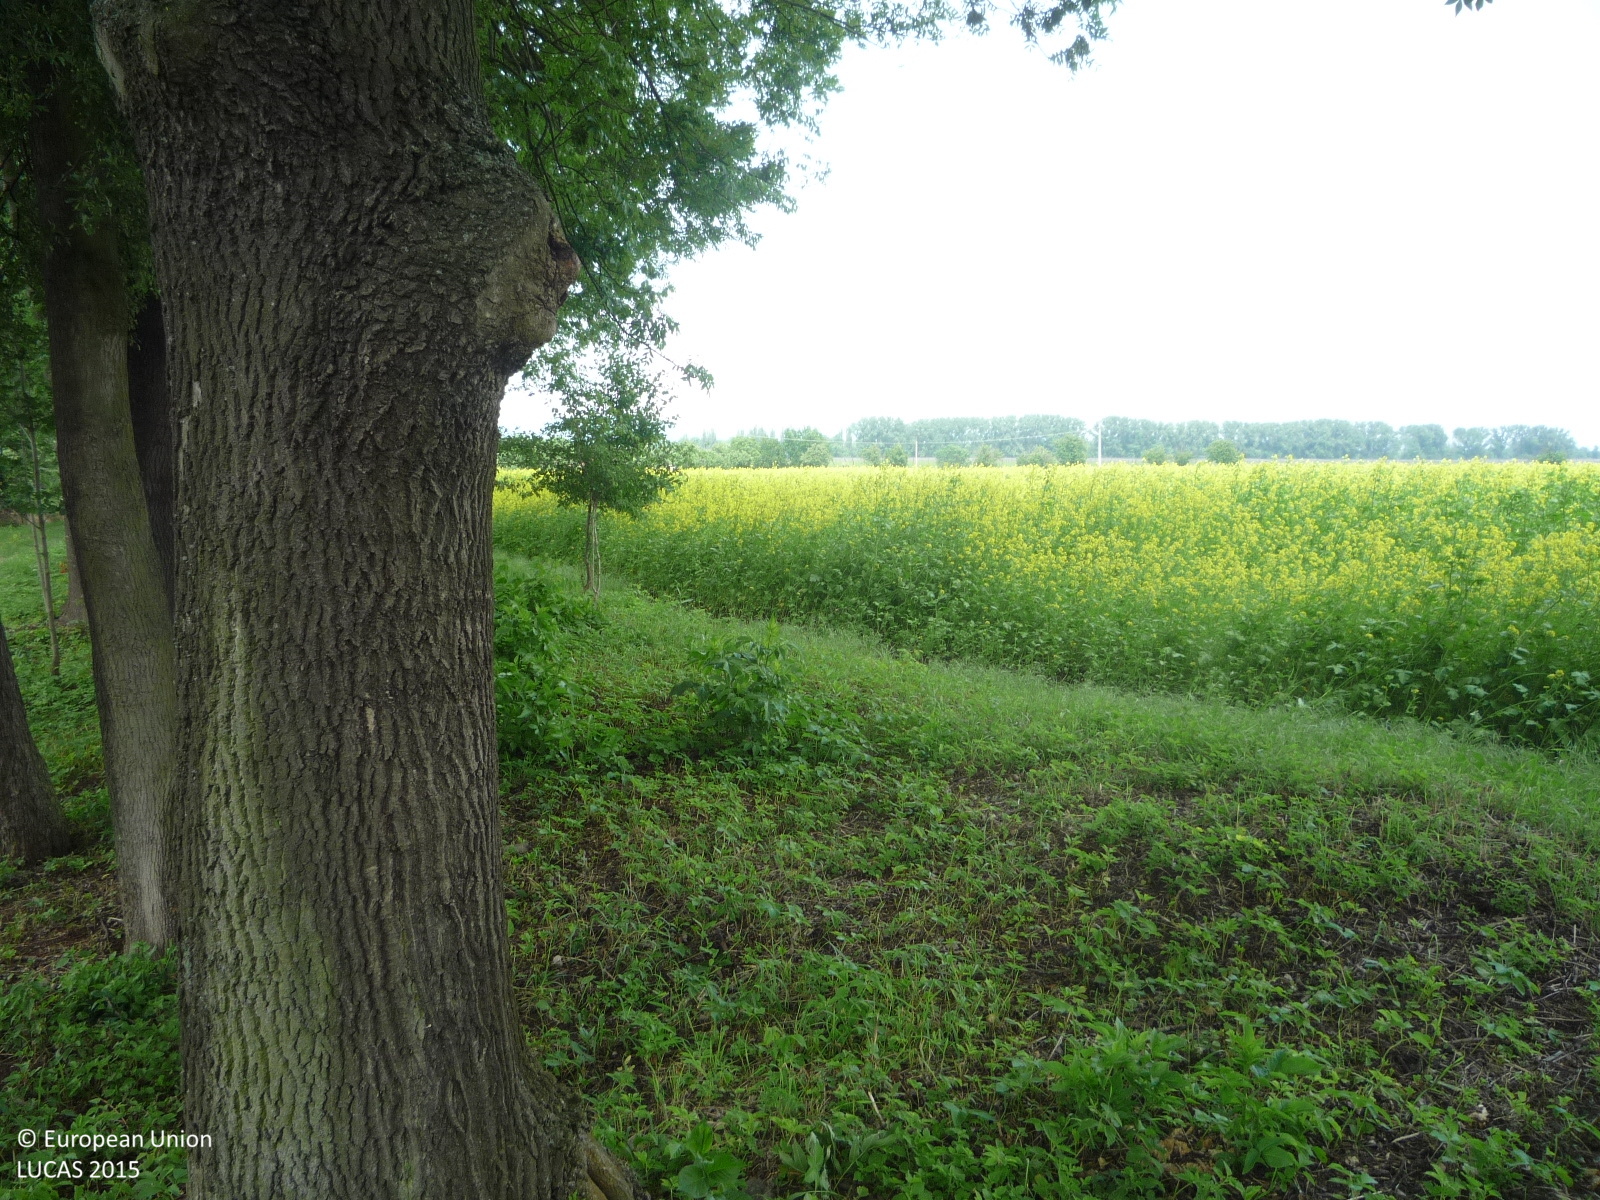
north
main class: Woodland
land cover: Broadleaved woodland
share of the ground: > 75 %
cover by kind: broadleaved forest trees 85 %, herbaceous plants 15 %
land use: Forestry
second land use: Amenities, museums, leisure
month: June
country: CZ
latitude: 50.3707
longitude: 13.8673
